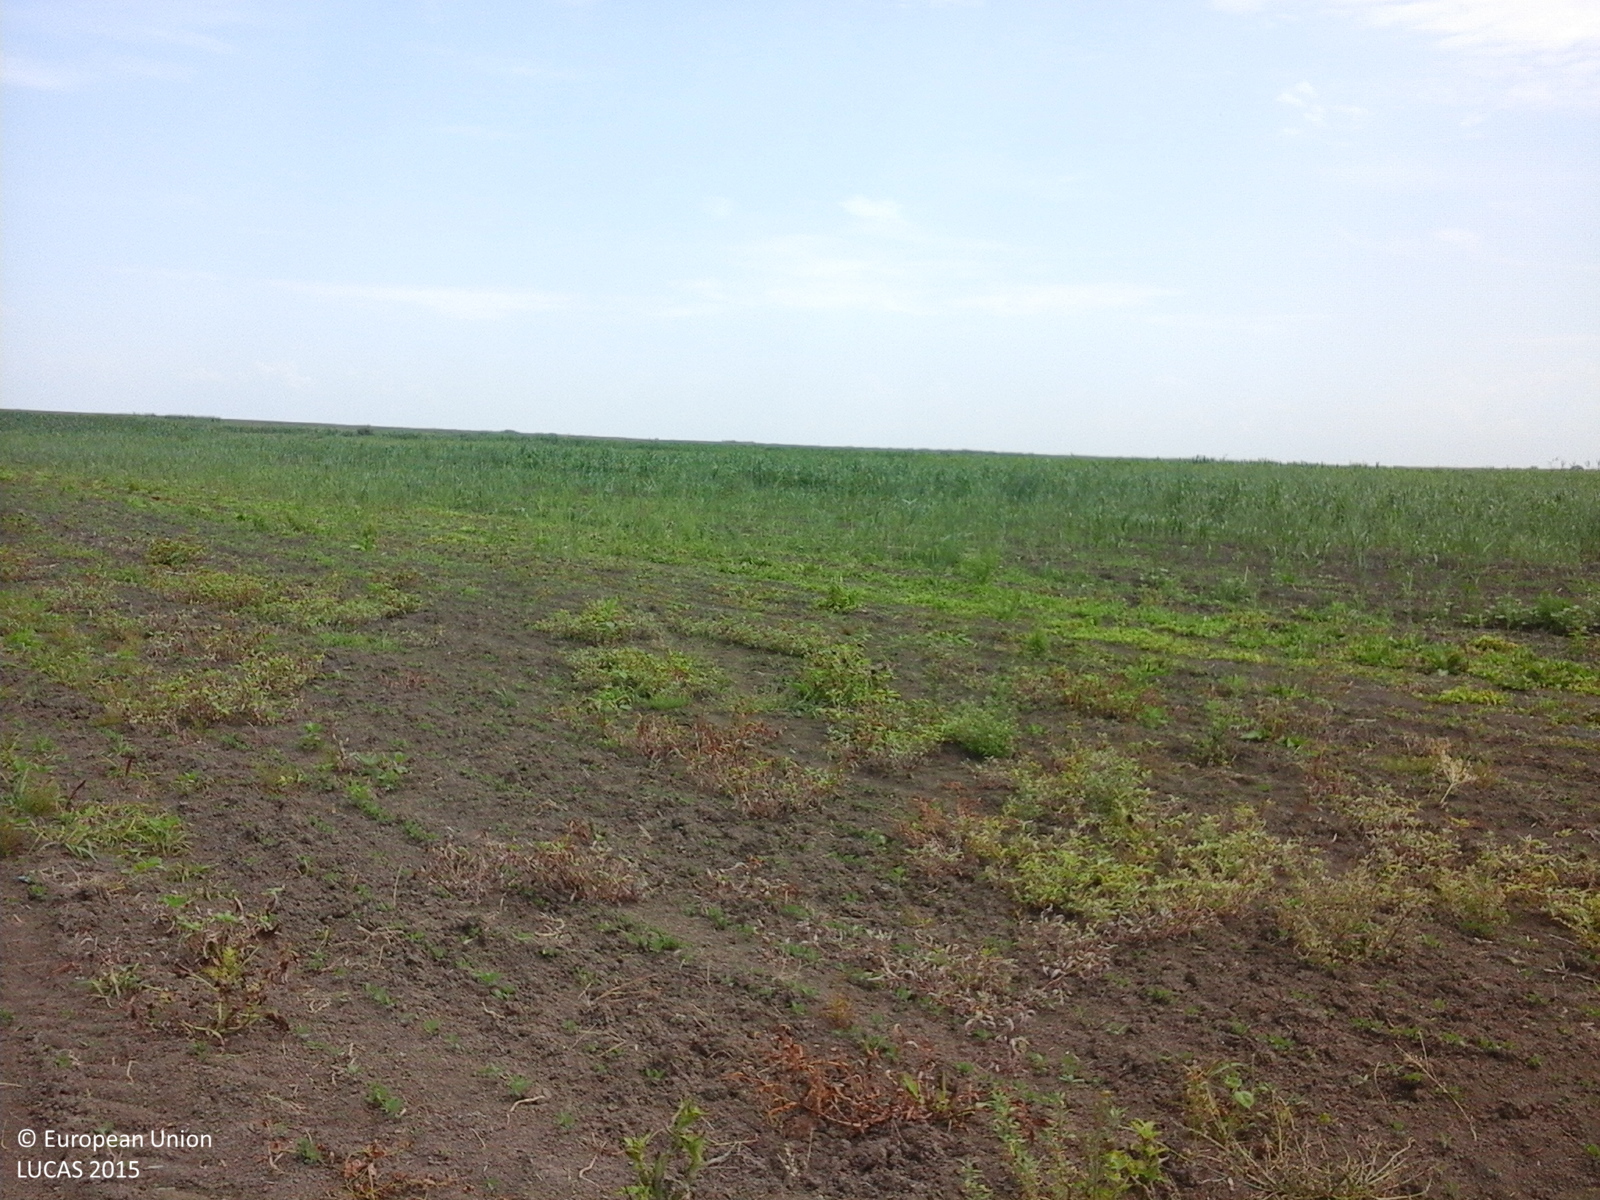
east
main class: Cropland
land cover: Soya
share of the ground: < 10 %
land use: Agriculture (excluding fallow land and kitchen gardens)
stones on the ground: < 10 %
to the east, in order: Soya; Maize; Lucerne
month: July
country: RO
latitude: 44.0228
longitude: 26.0816
